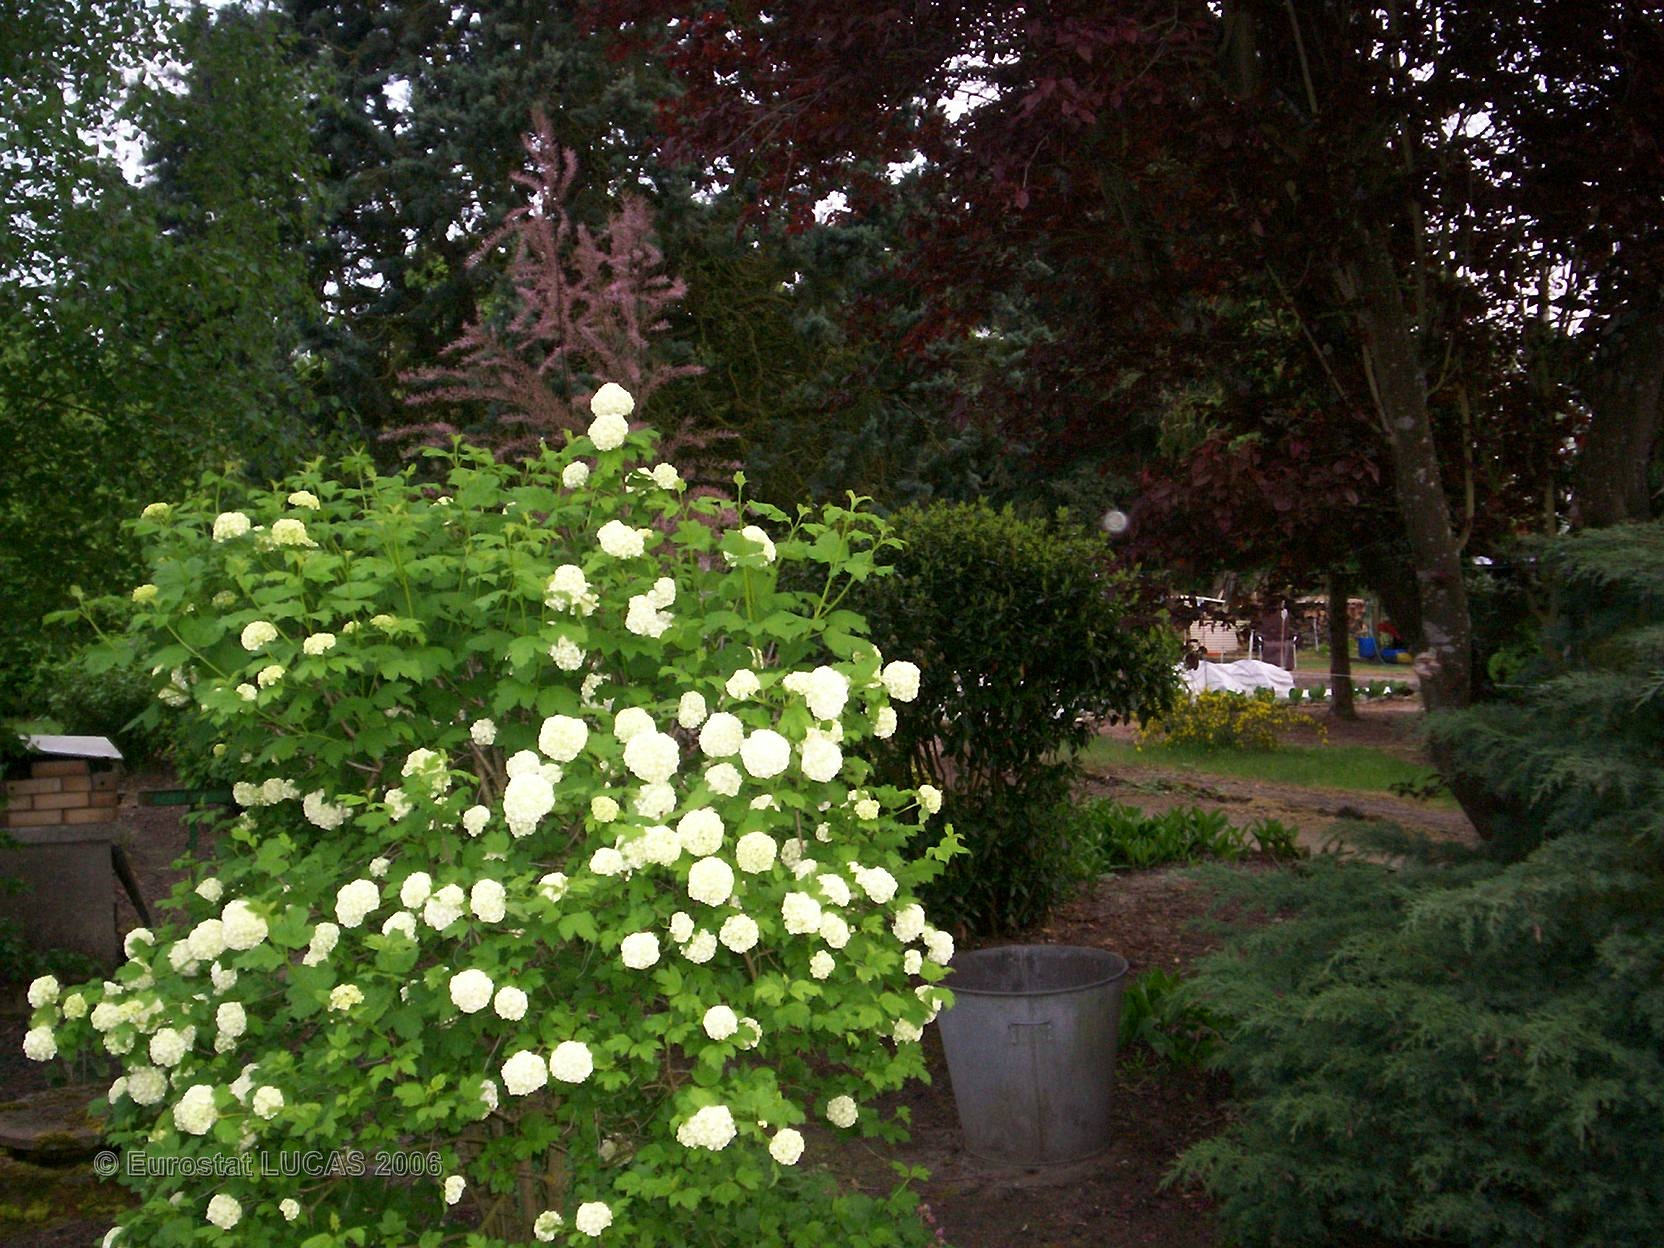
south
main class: Grassland
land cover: Grassland with sparse tree/shrub cover
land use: Residential
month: May
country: FR
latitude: 47.8766
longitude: 0.2004
